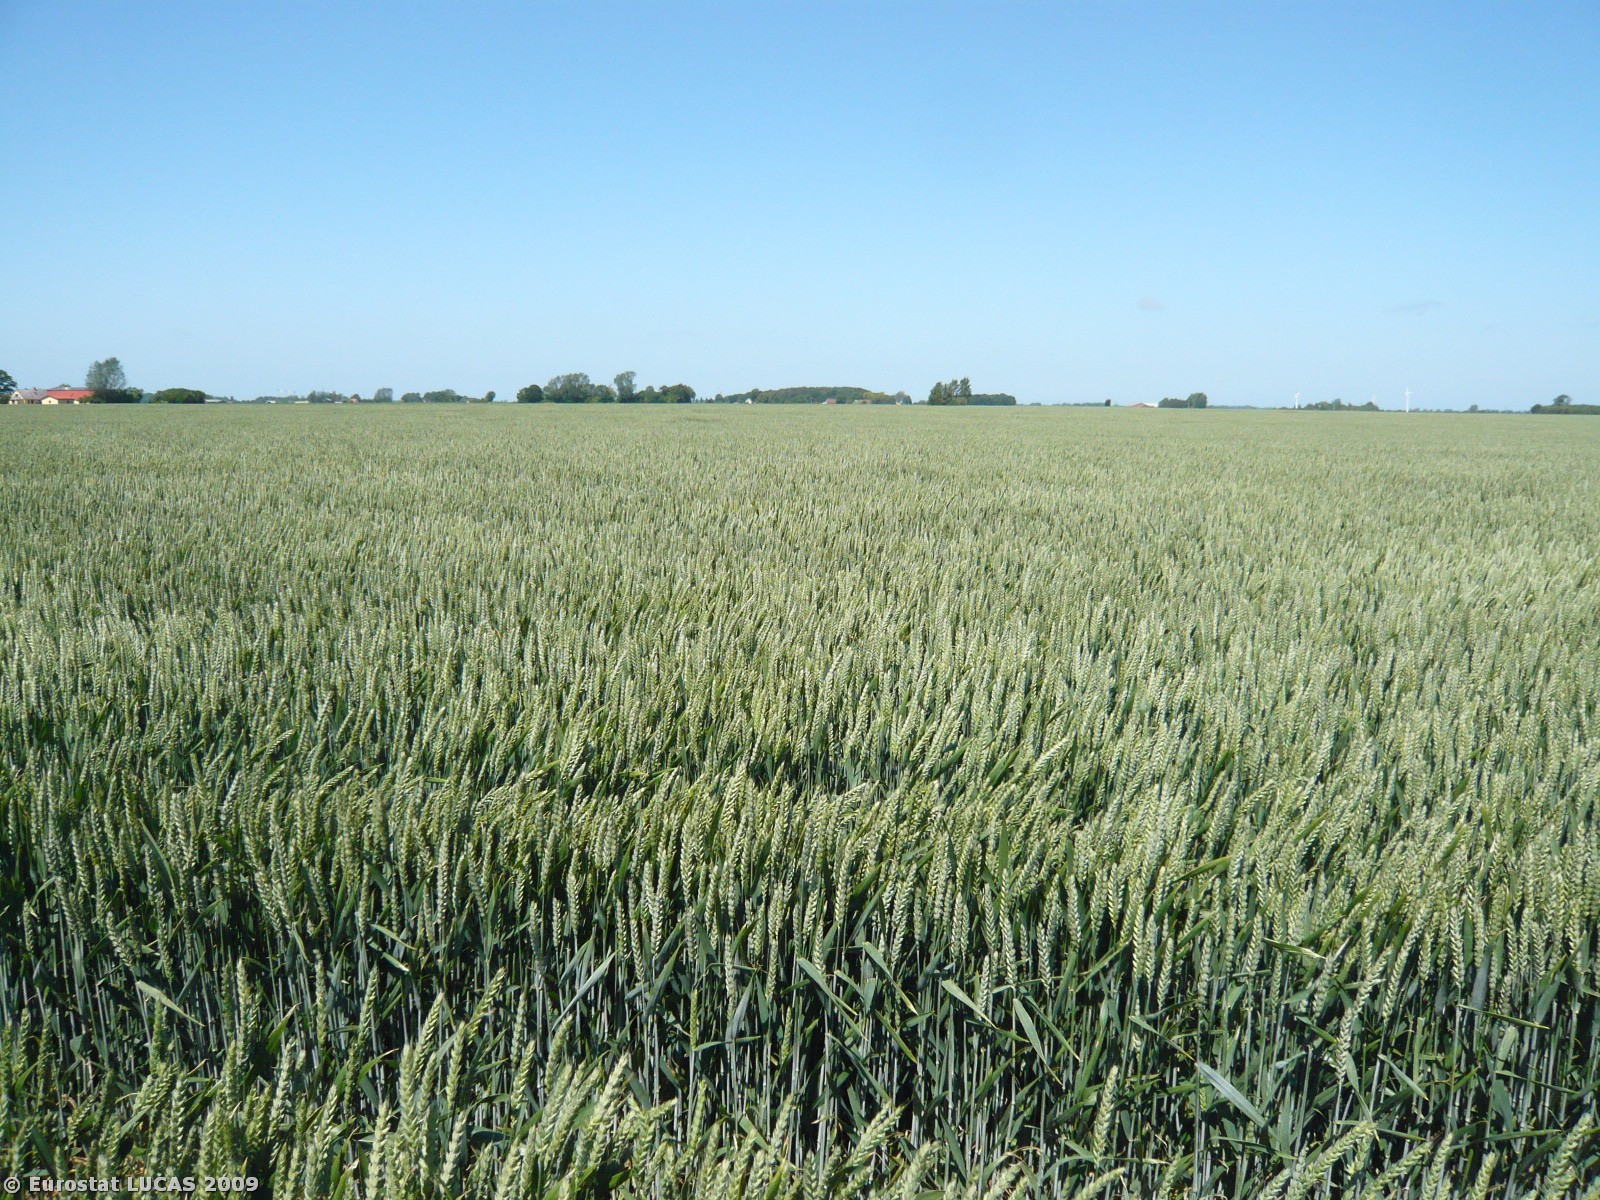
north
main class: Cropland
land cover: Common wheat
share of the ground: > 75 %
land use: Agriculture (excluding fallow land and kitchen gardens)
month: June
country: DK
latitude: 54.7621
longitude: 11.1958
